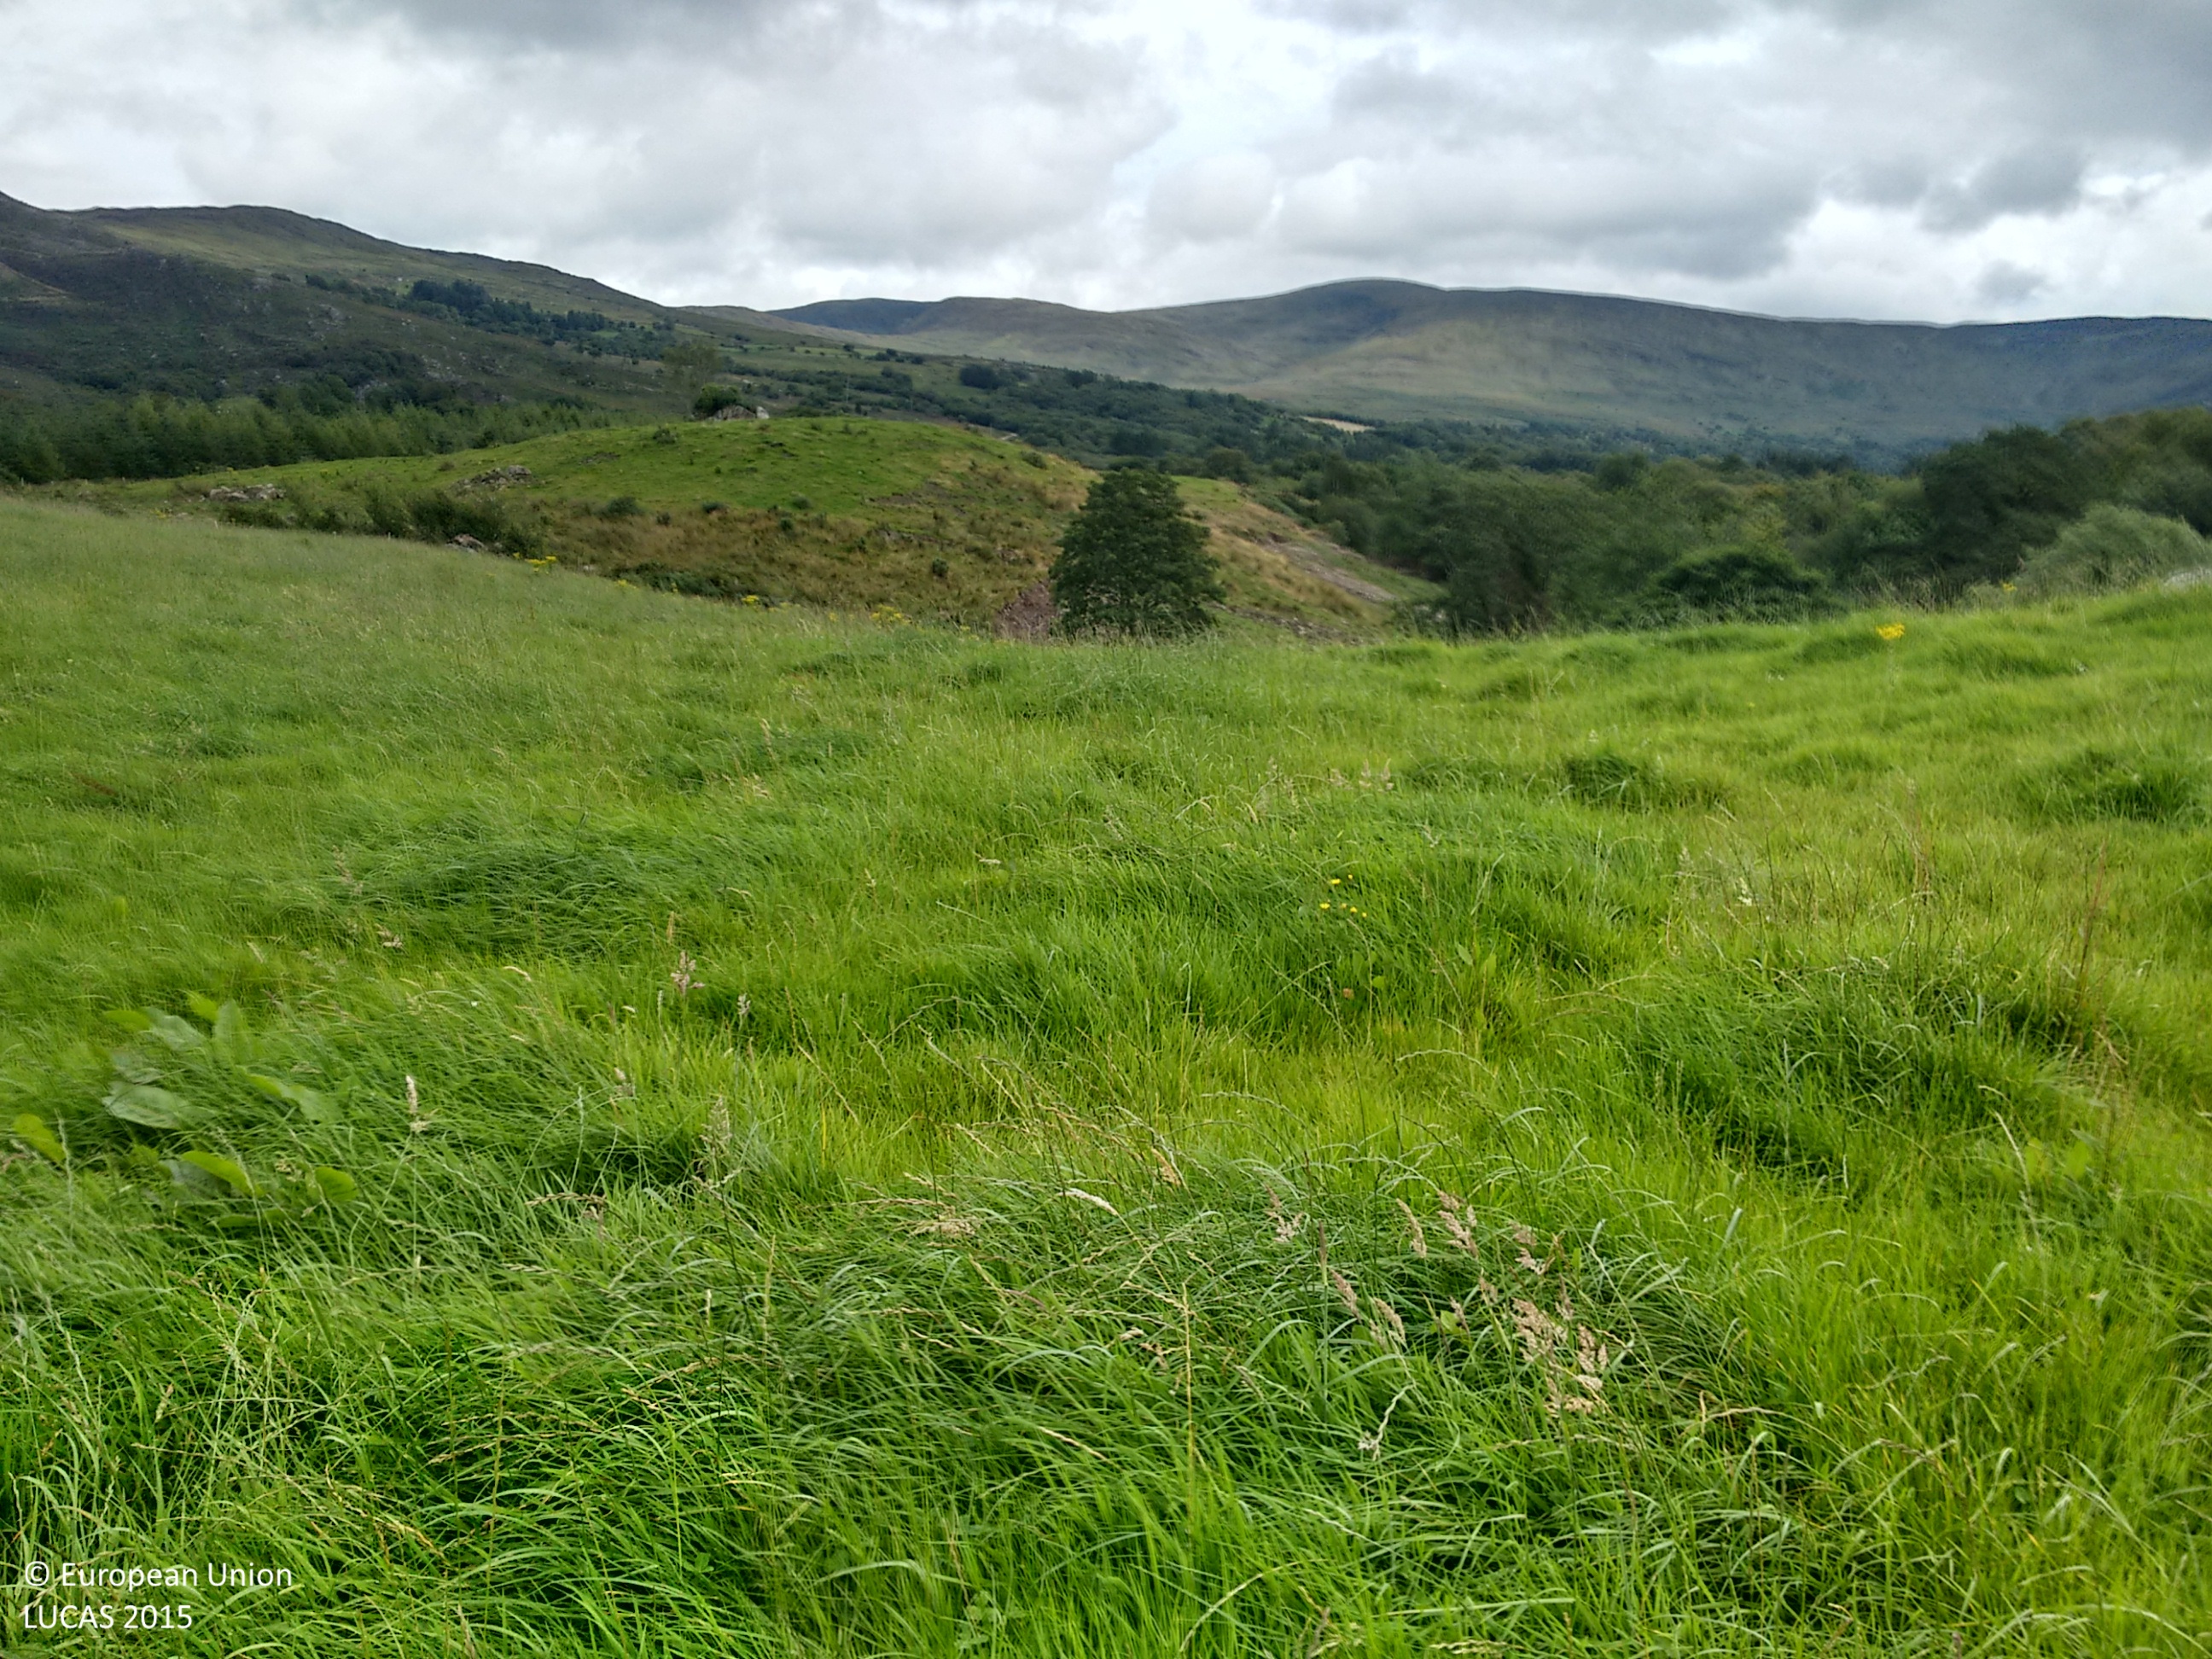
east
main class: Grassland
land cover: Grassland without tree/shrub cover
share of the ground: > 75 %
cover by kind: herbaceous plants 100 %
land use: Agriculture (excluding fallow land and kitchen gardens)
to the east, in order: Grassland without tree/shrub cover; Fences; Abandoned hedges; Grassland with sparse tree/shrub cover; Grassland without tree/shrub cover; Fences; Shruby margins; Spruce dominated coniferous woodland
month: August
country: IE
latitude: 51.8612
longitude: -9.5325
